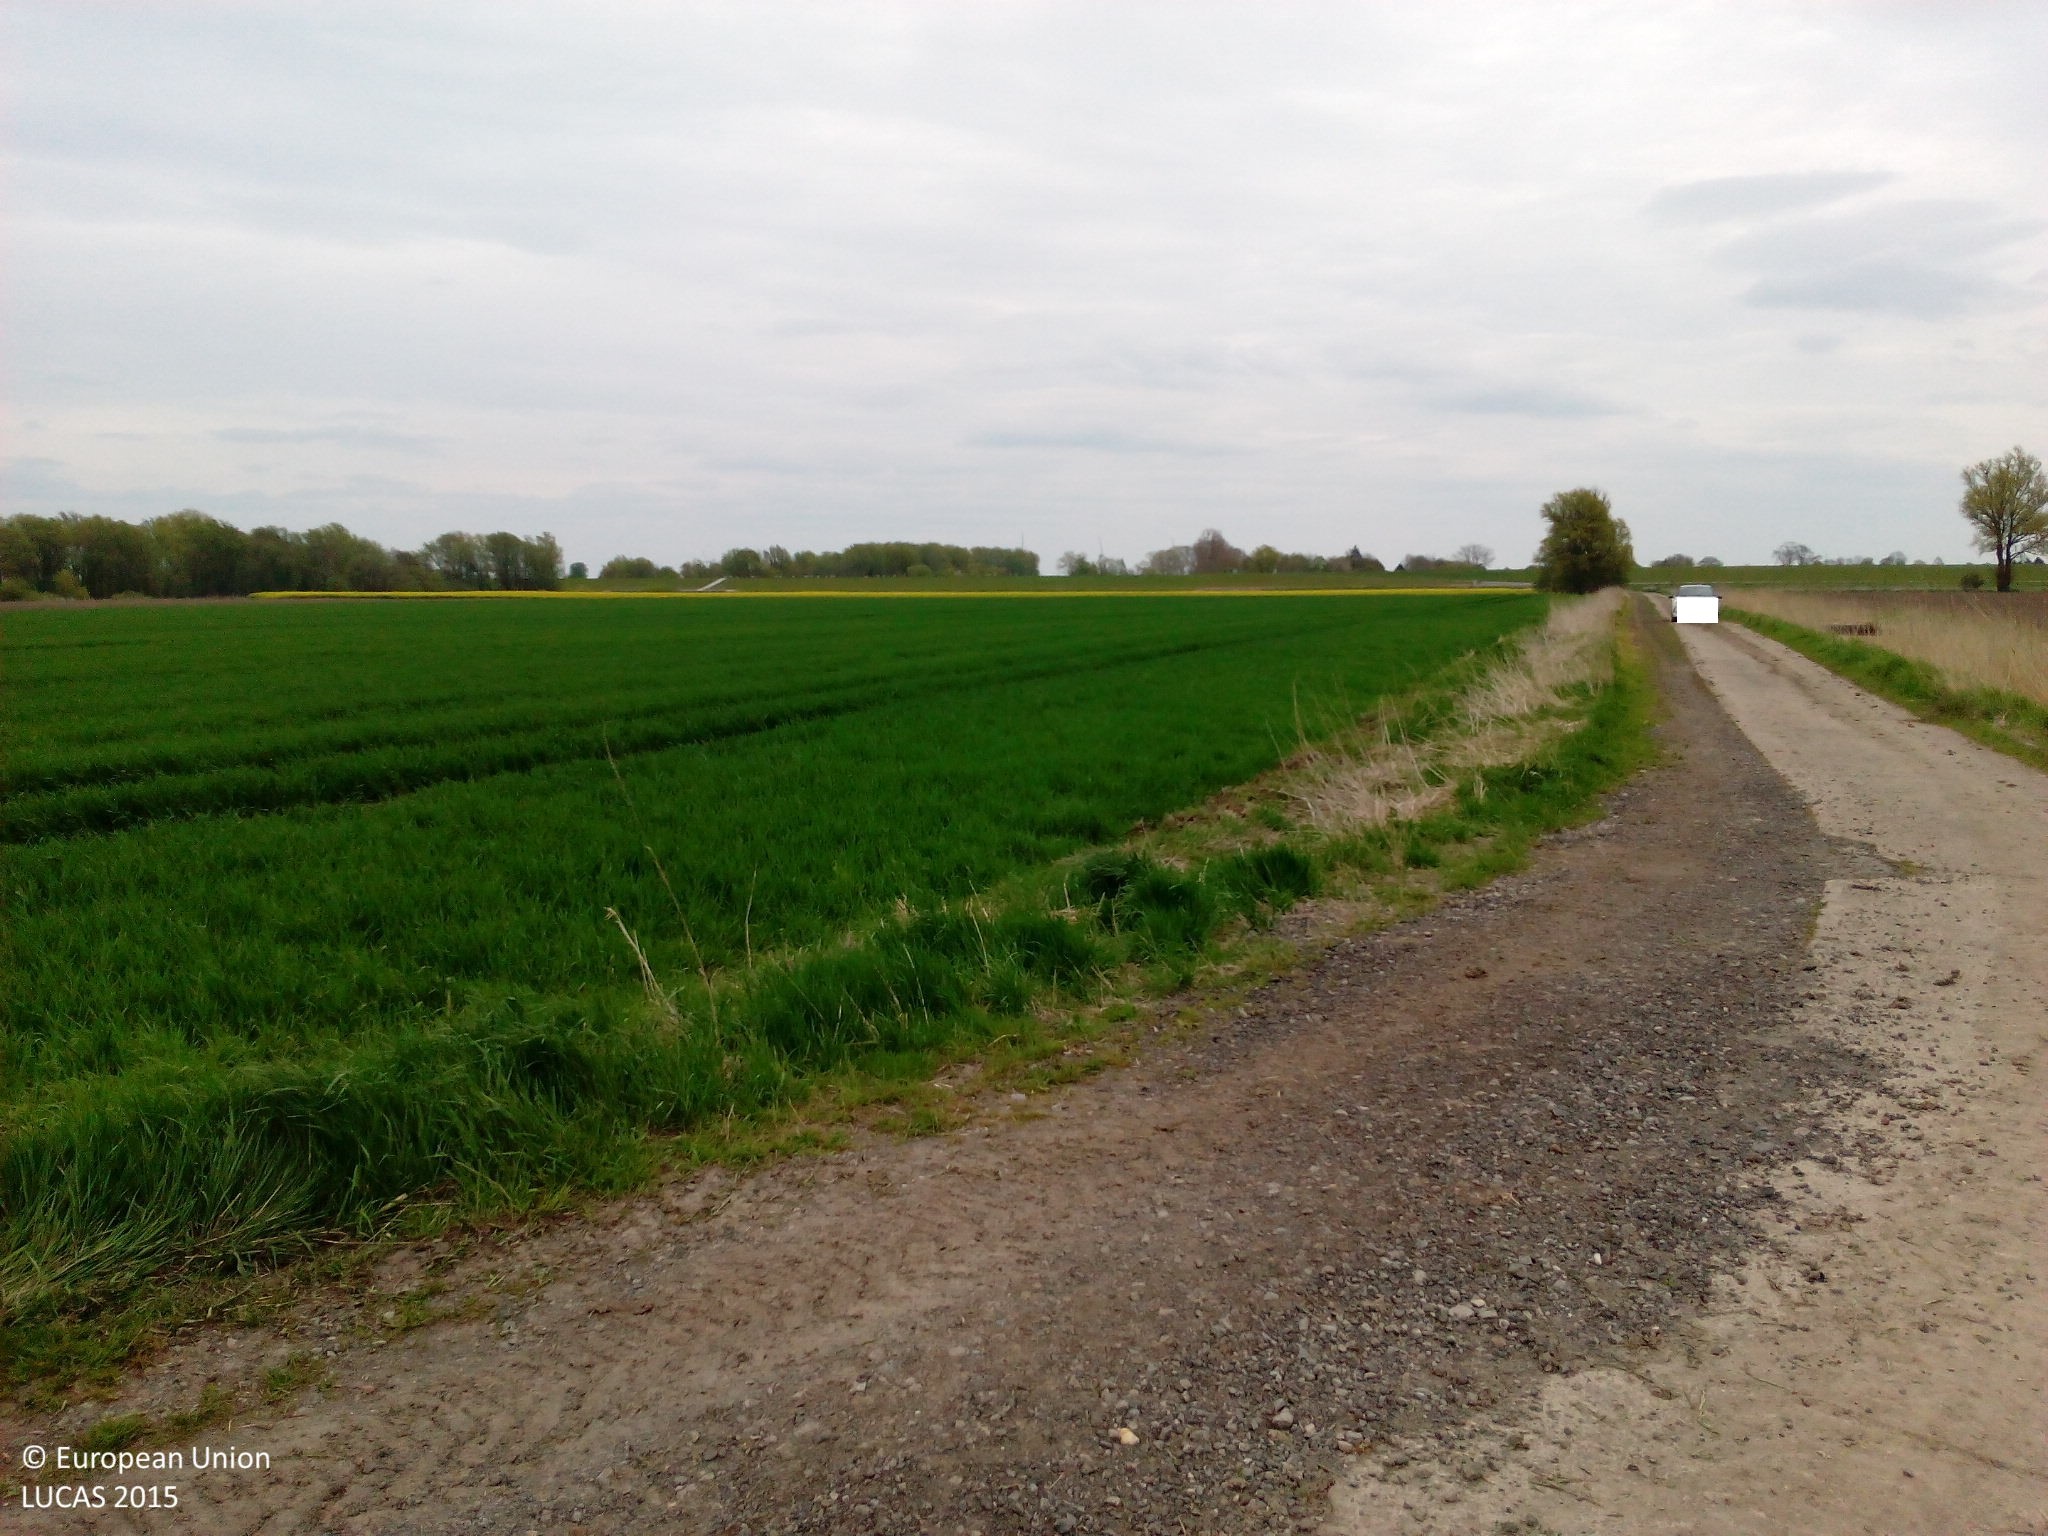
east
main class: Grassland
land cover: Grassland without tree/shrub cover
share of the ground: > 75 %
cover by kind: herbaceous plants 100 %
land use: Agriculture (excluding fallow land and kitchen gardens)
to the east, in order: Grassland without tree/shrub cover; Ditches and canals; Grass margins; Other bare soil
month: May
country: DE
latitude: 53.2850
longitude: 8.5156
